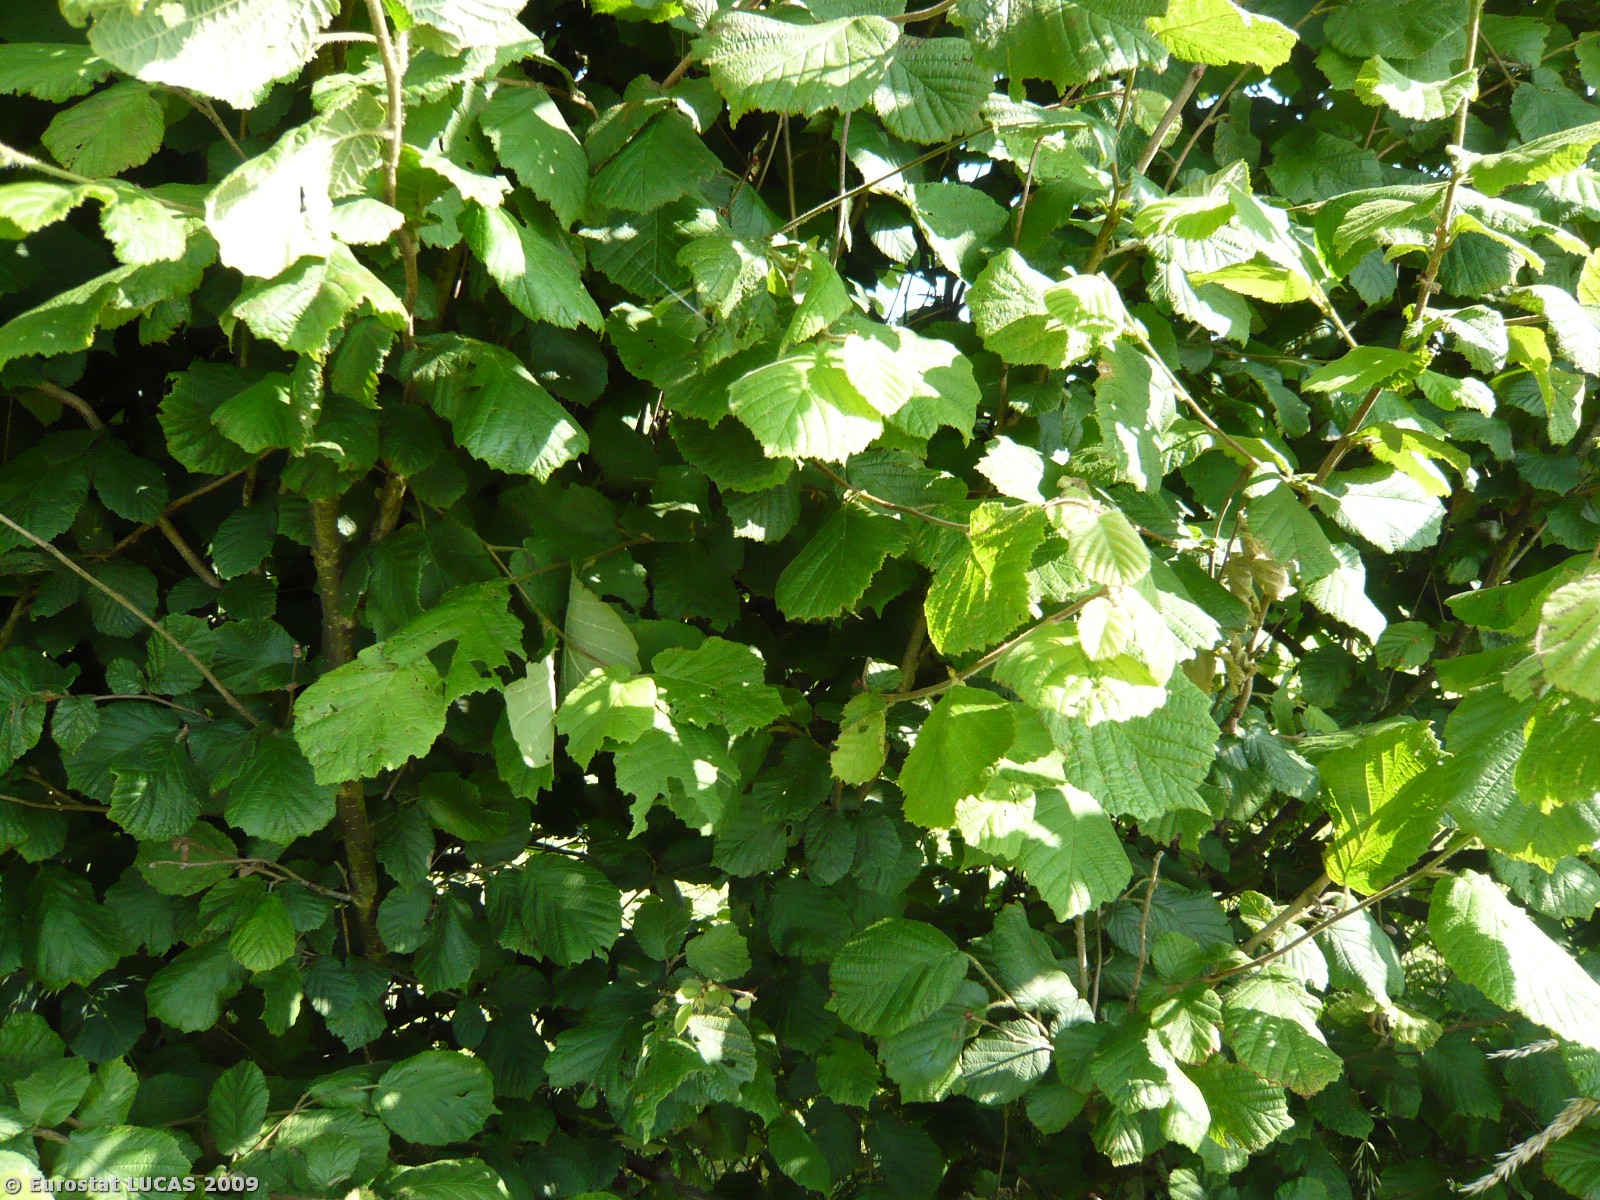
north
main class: Cropland
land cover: Triticale
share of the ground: > 75 %
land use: Agriculture (excluding fallow land and kitchen gardens)
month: June
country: DK
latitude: 55.2170
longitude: 10.1728
